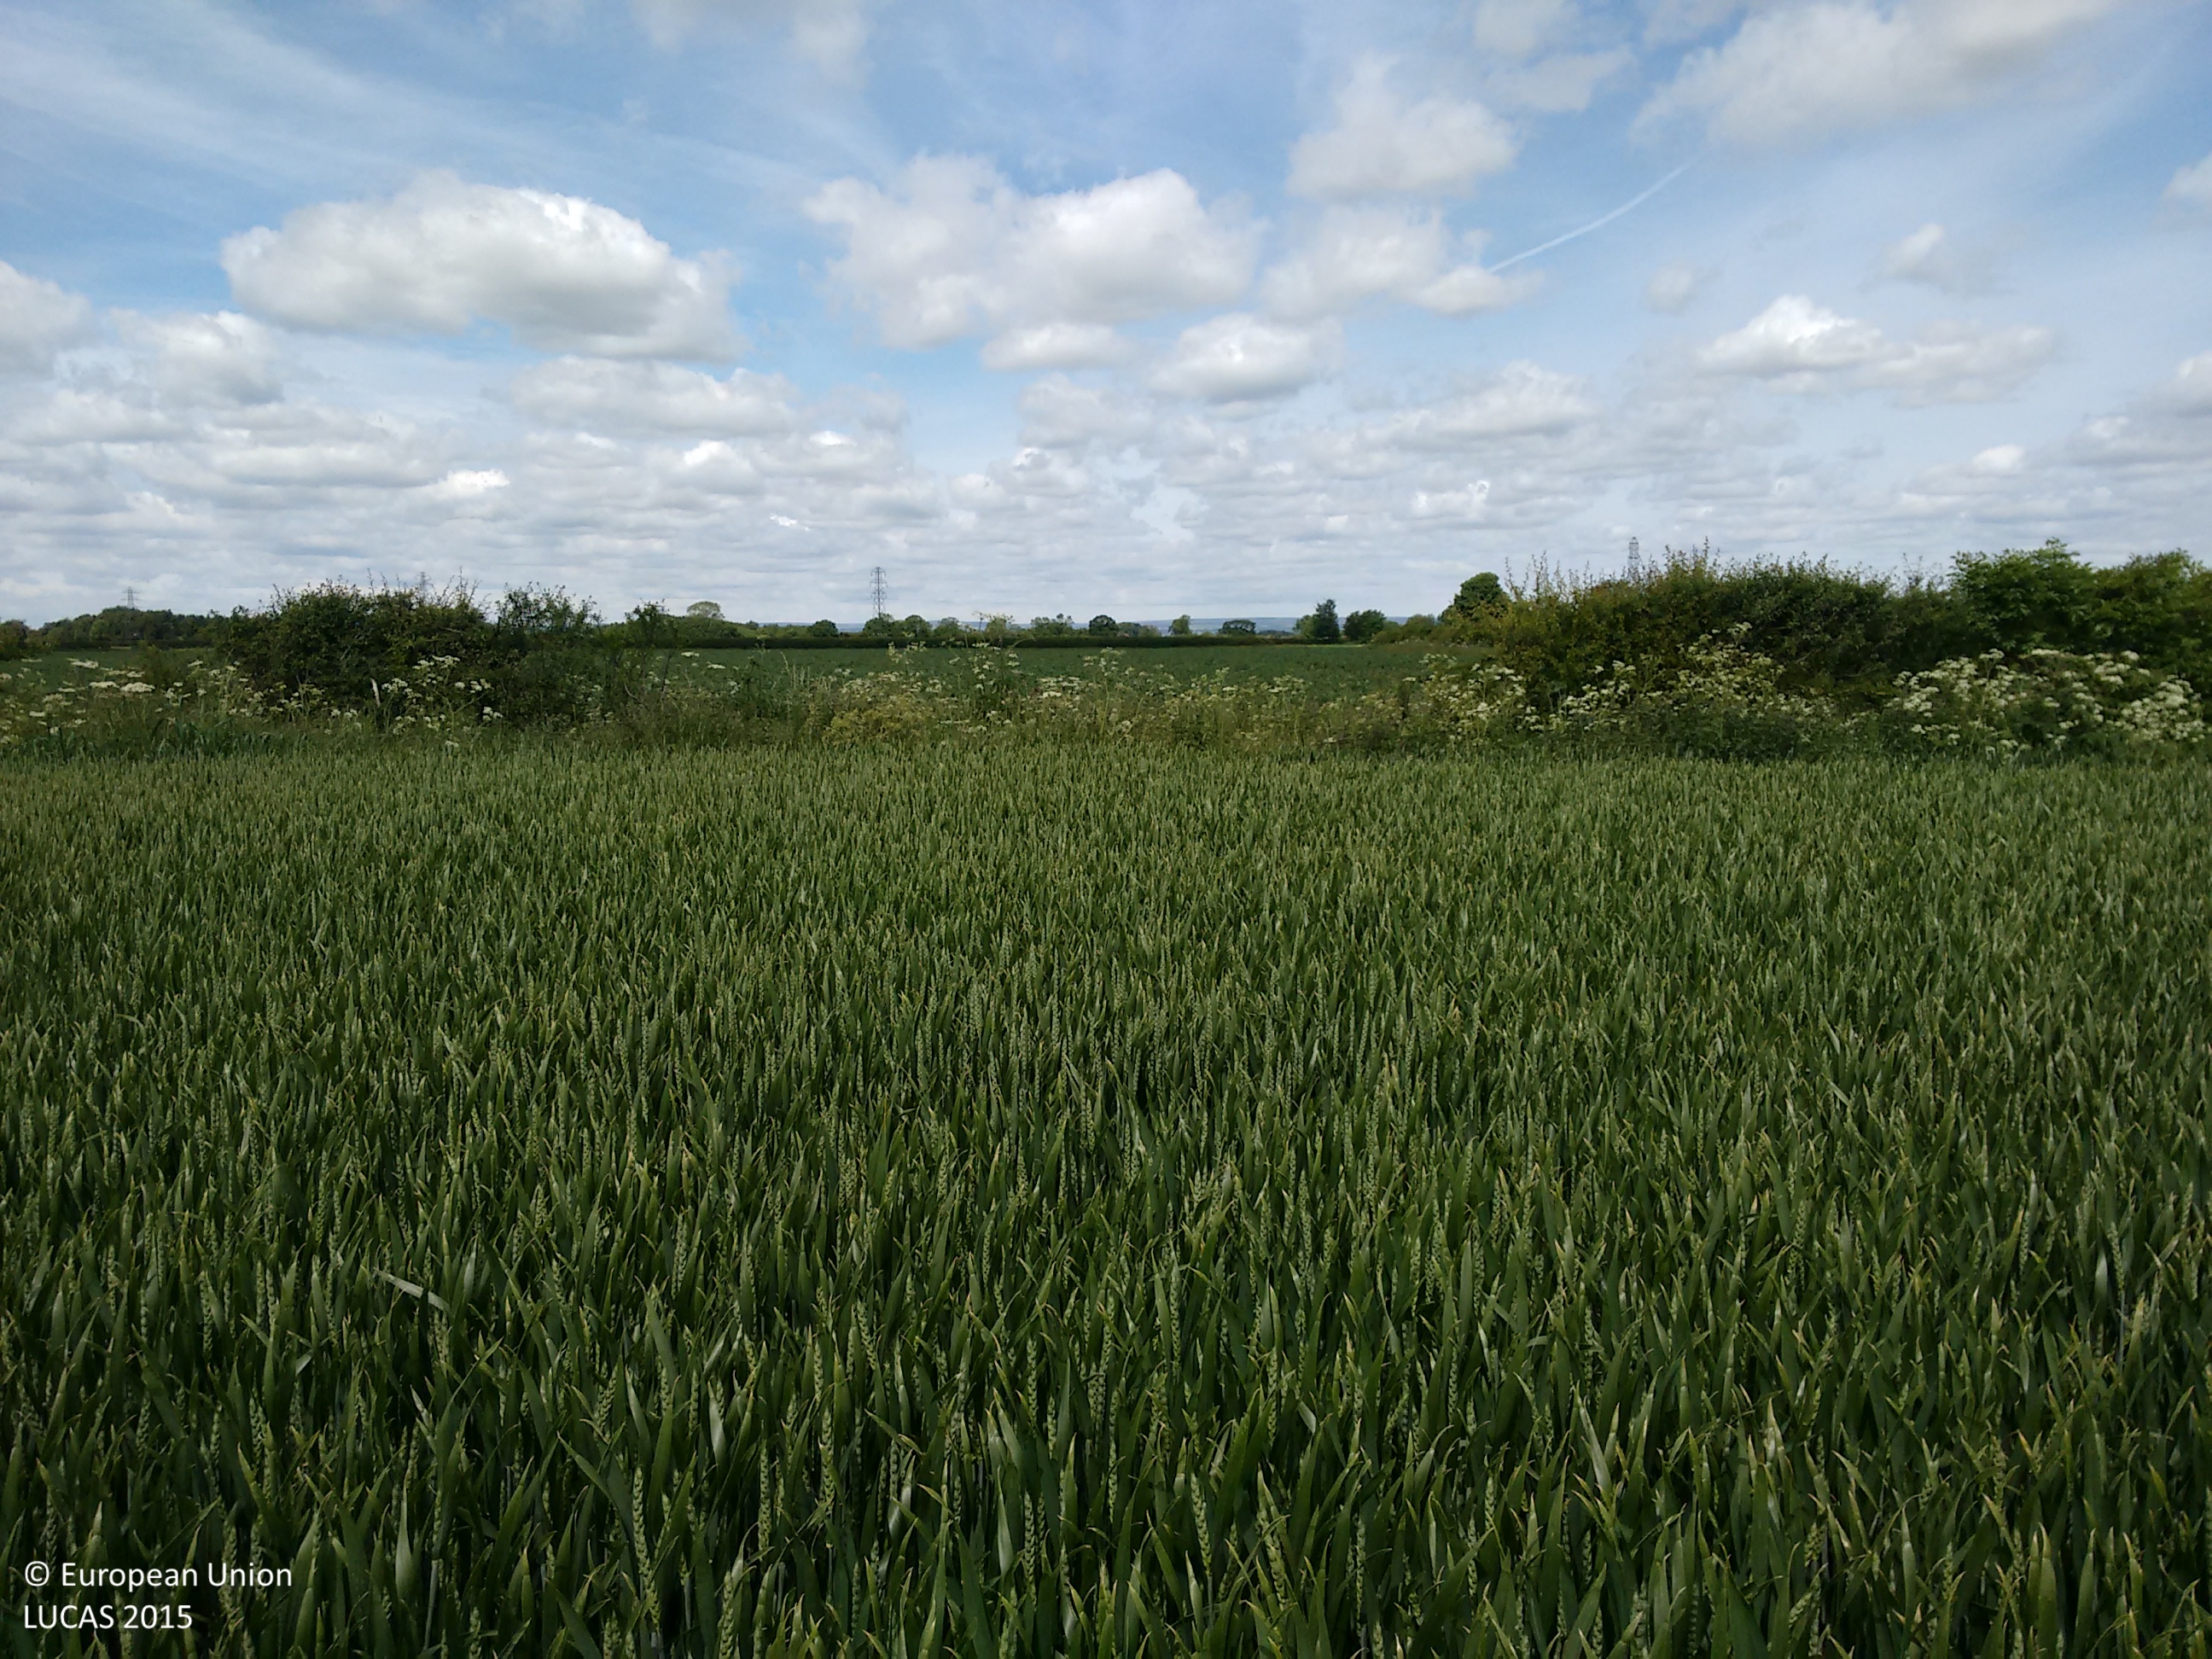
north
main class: Cropland
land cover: Common wheat
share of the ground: > 75 %
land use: Agriculture (excluding fallow land and kitchen gardens)
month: June
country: GB
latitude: 54.1510
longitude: -0.8037
